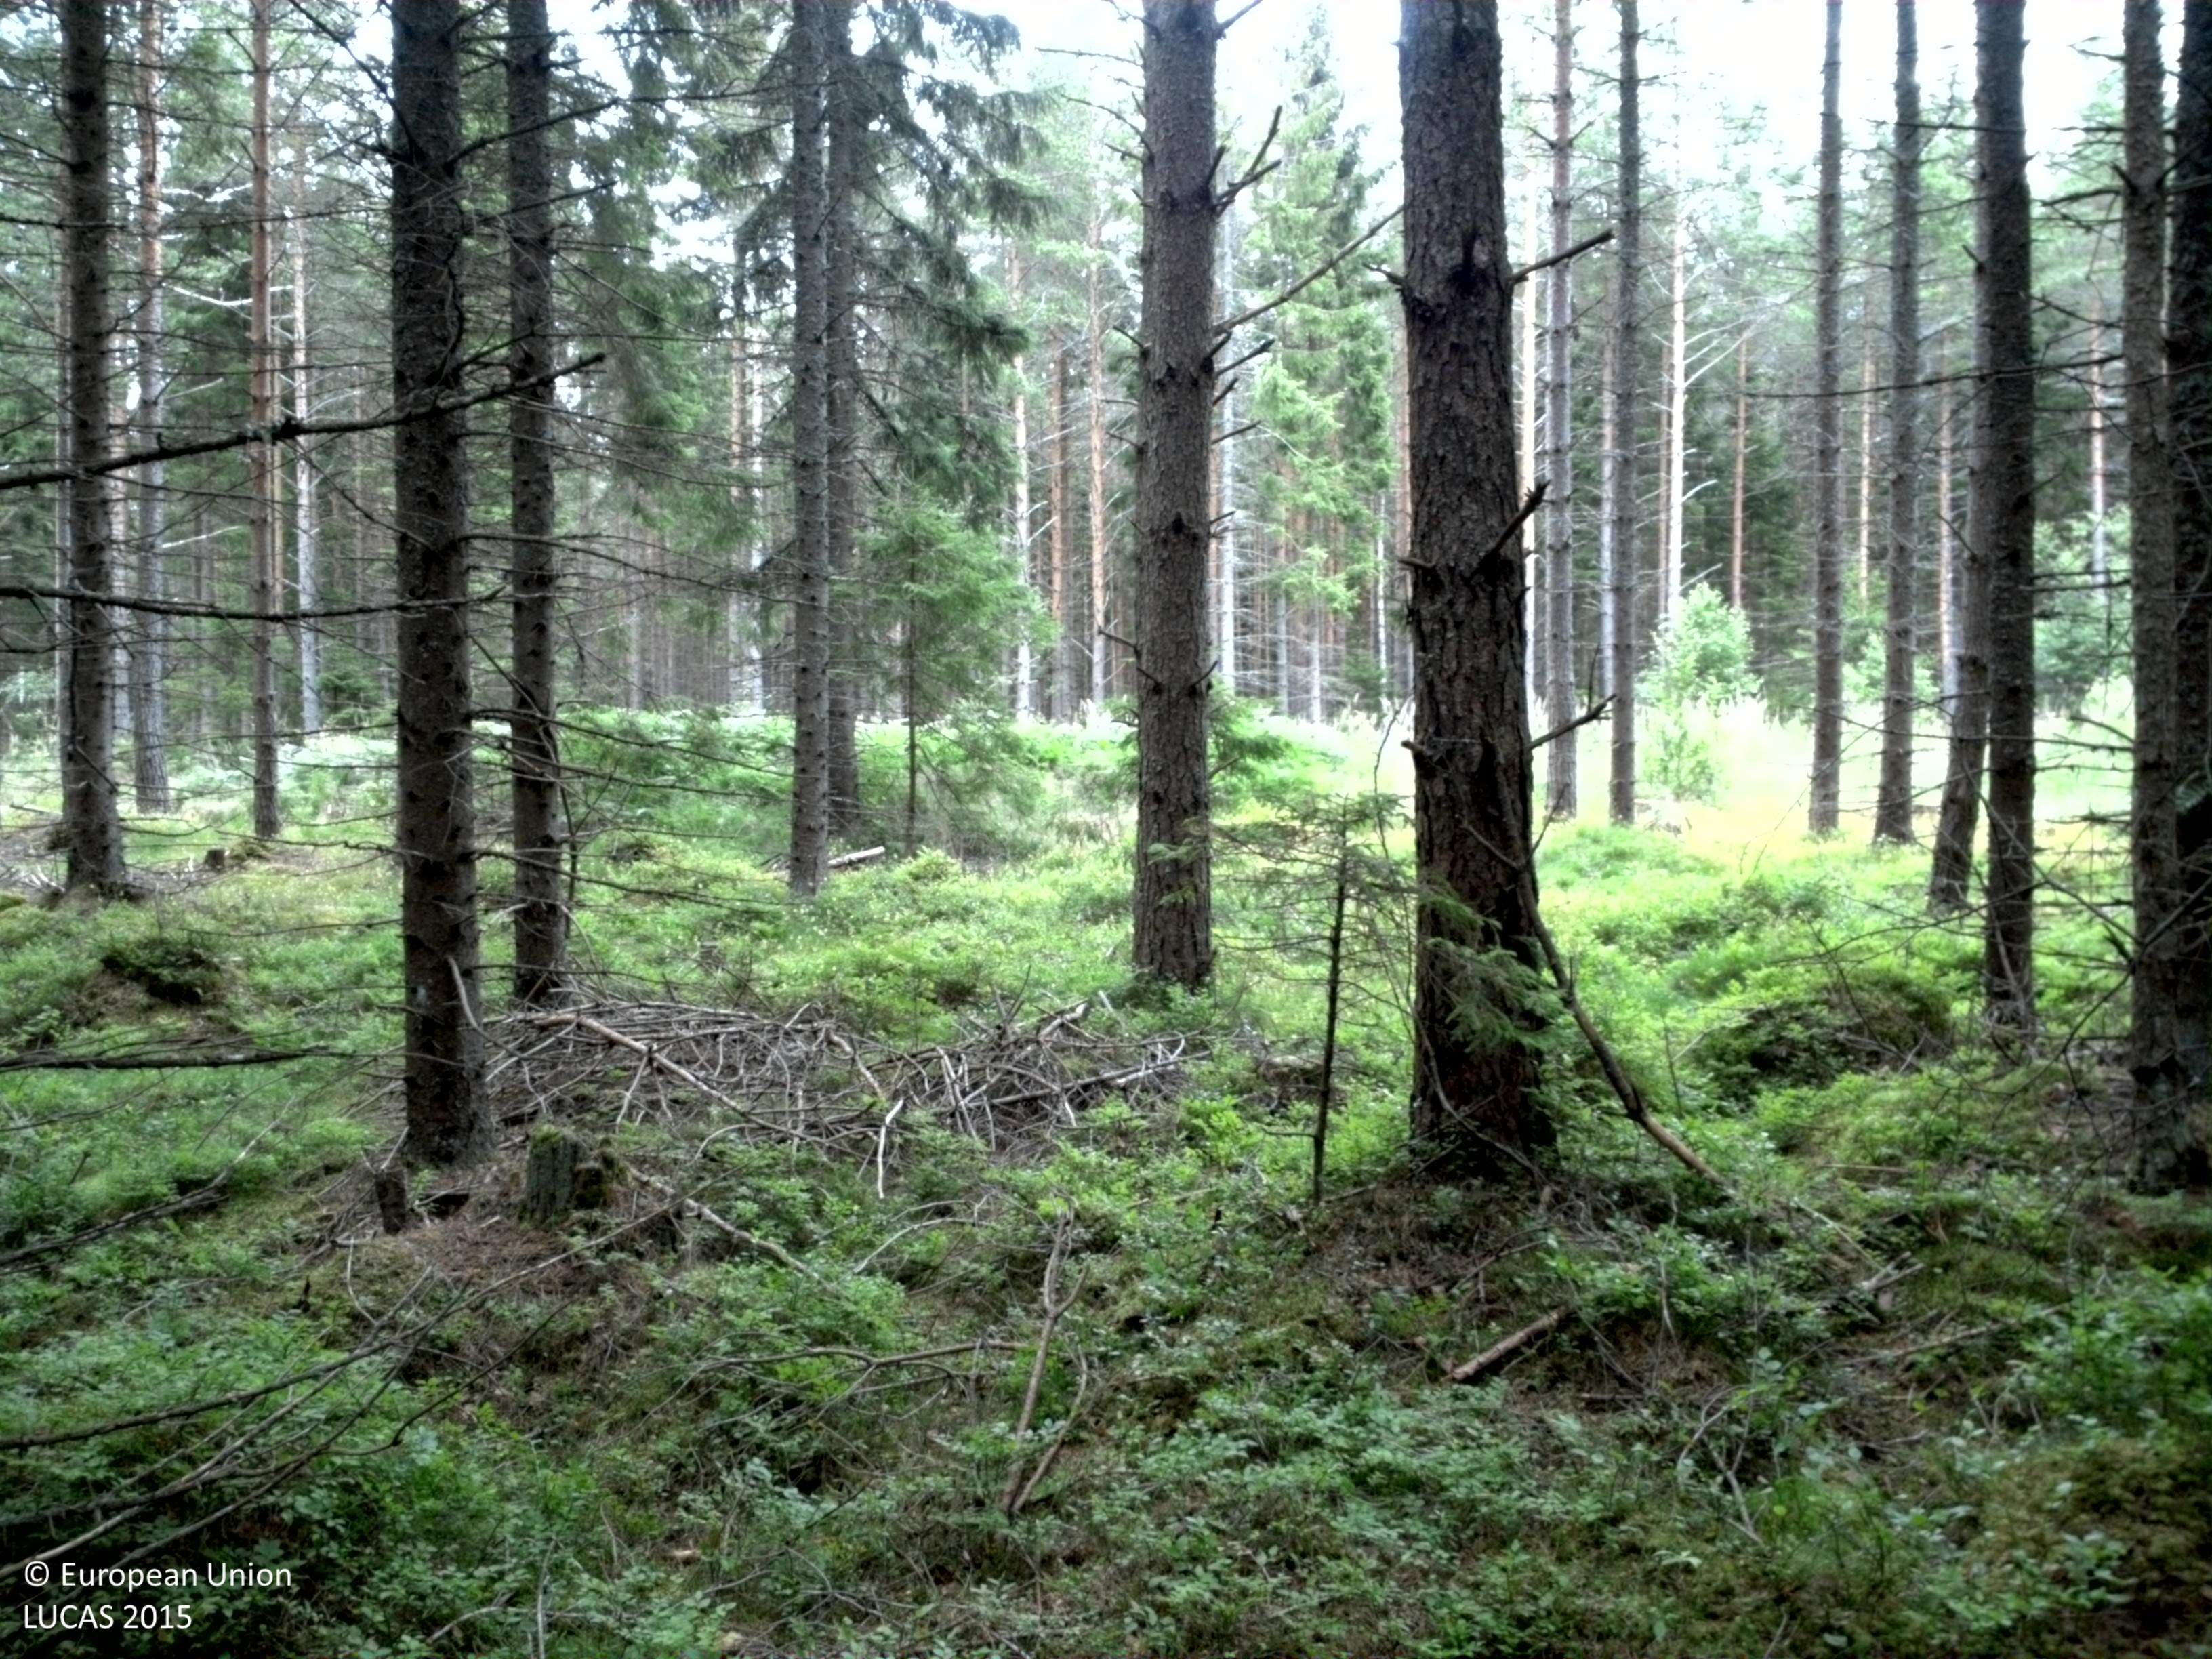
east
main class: Woodland
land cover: Other coniferous woodland
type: boreal forest
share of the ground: 25 - 50 %
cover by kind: coniferous forest trees 45 %, herbaceous plants 35 %, lichens and mosses 20 %
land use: Forestry
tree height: > 5 m
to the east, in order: Other coniferous woodland; Grass margins; Paved roads, cycling and walking lanes; Grass margins; Groves; Ditches and canals; Other coniferous woodland; Tracks; Other coniferous woodland; Electric lines; Other coniferous woodland; Spruce dominated mixed woodland
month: July
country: SE
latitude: 58.9385
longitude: 14.4582
